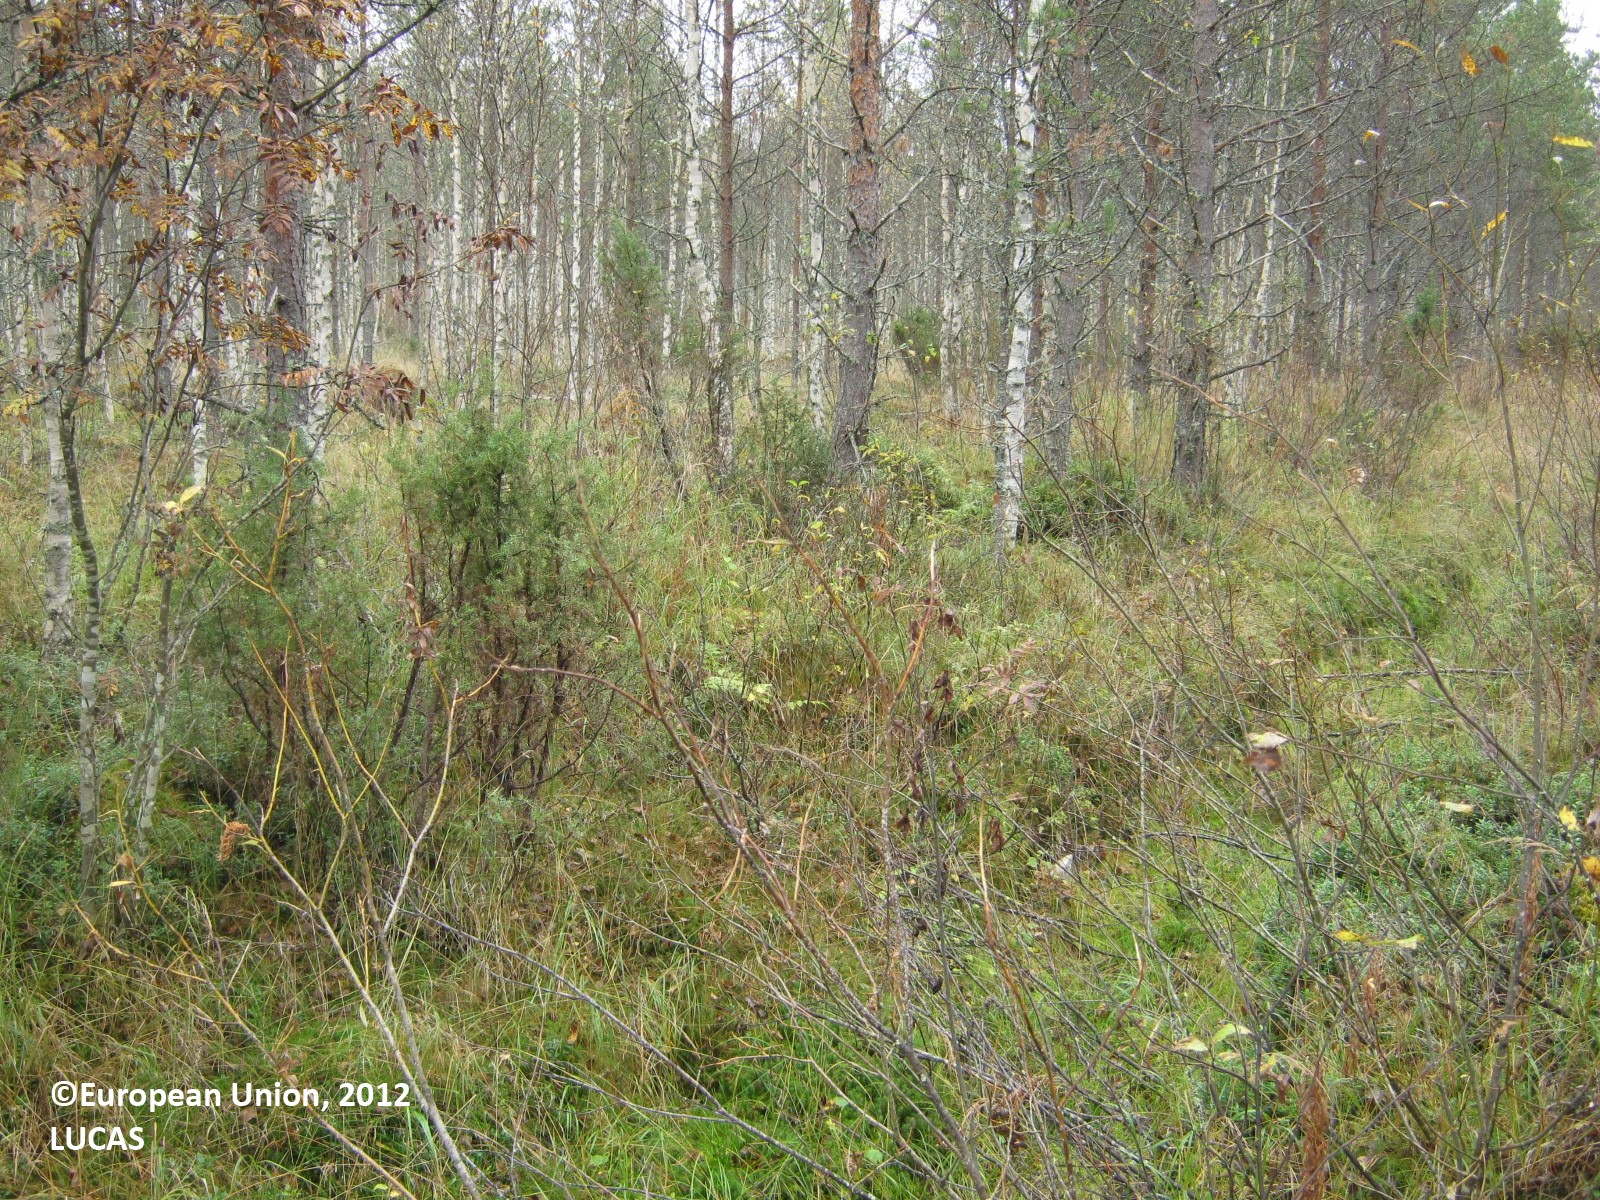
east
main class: Woodland
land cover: Other mixed woodland
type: boreal forest
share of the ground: > 75 %
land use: Forestry
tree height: > 5 m
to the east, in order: Other mixed woodland; Ditches and canals; Other mixed woodland; Ditches and canals; Pine dominated mixed woodland
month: September
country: FI
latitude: 63.3813
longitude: 25.9372
